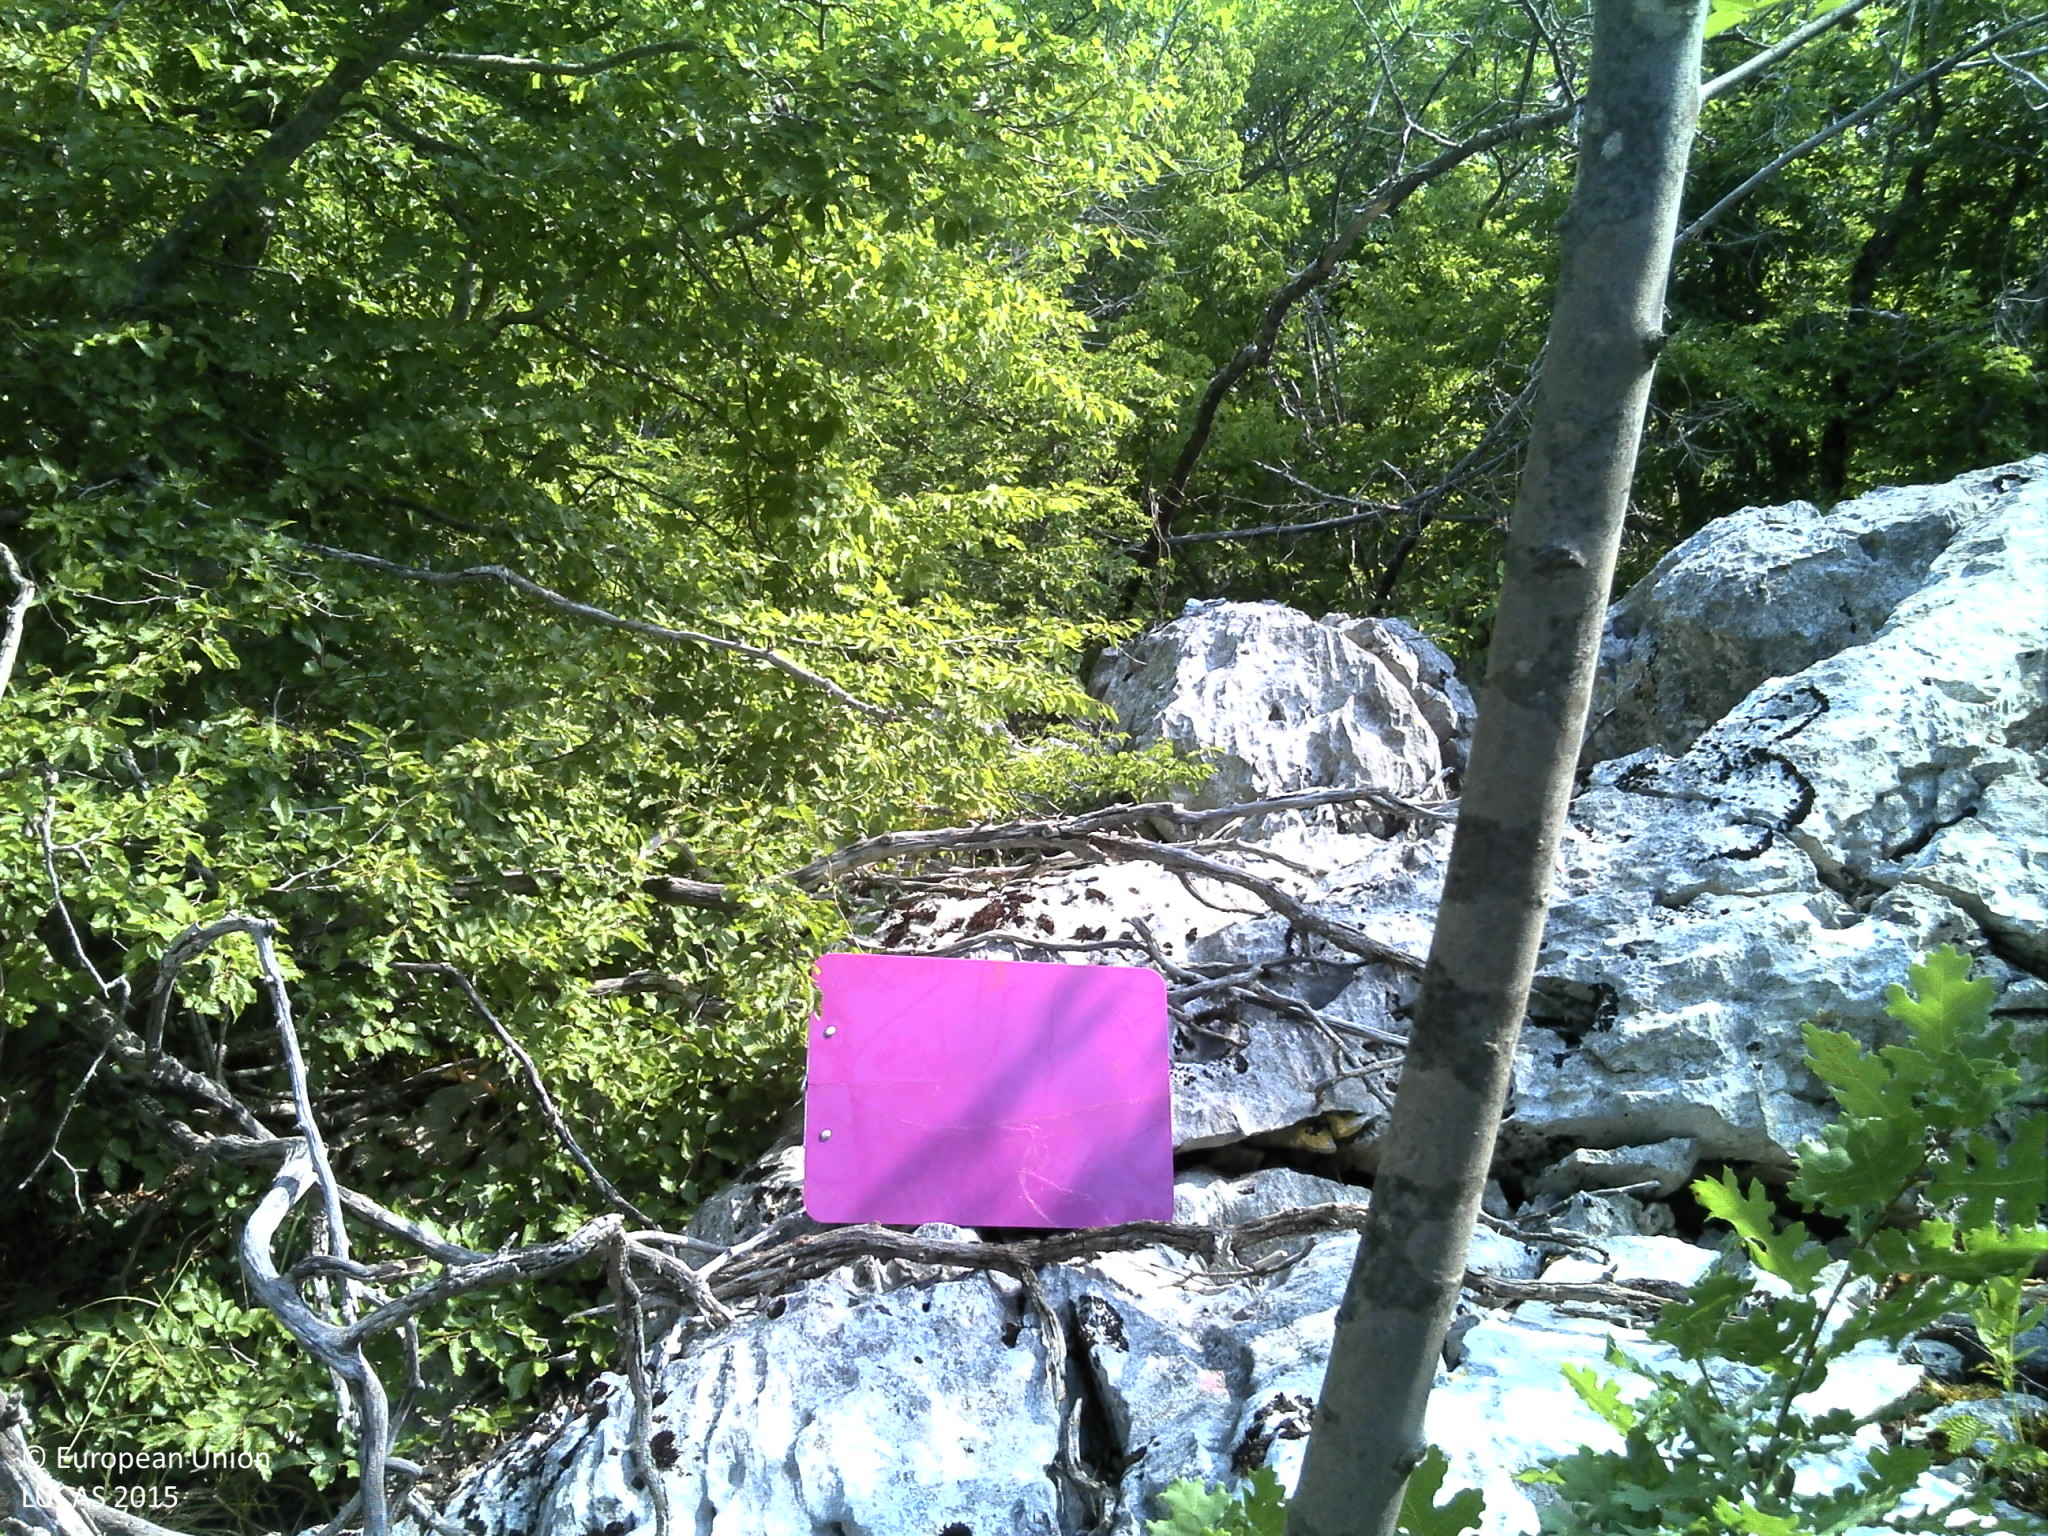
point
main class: Woodland
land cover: Other mixed woodland
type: thermophilous deciduous forest
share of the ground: > 75 %
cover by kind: broadleaved forest trees 45 %, coniferous forest trees 30 %, shrubs 10 %, consolidated bare surface 10 %, herbaceous plants 5 %
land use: Semi-natural and natural areas not in use
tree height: > 5 m
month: July
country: HR
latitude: 43.4853
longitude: 16.9280
